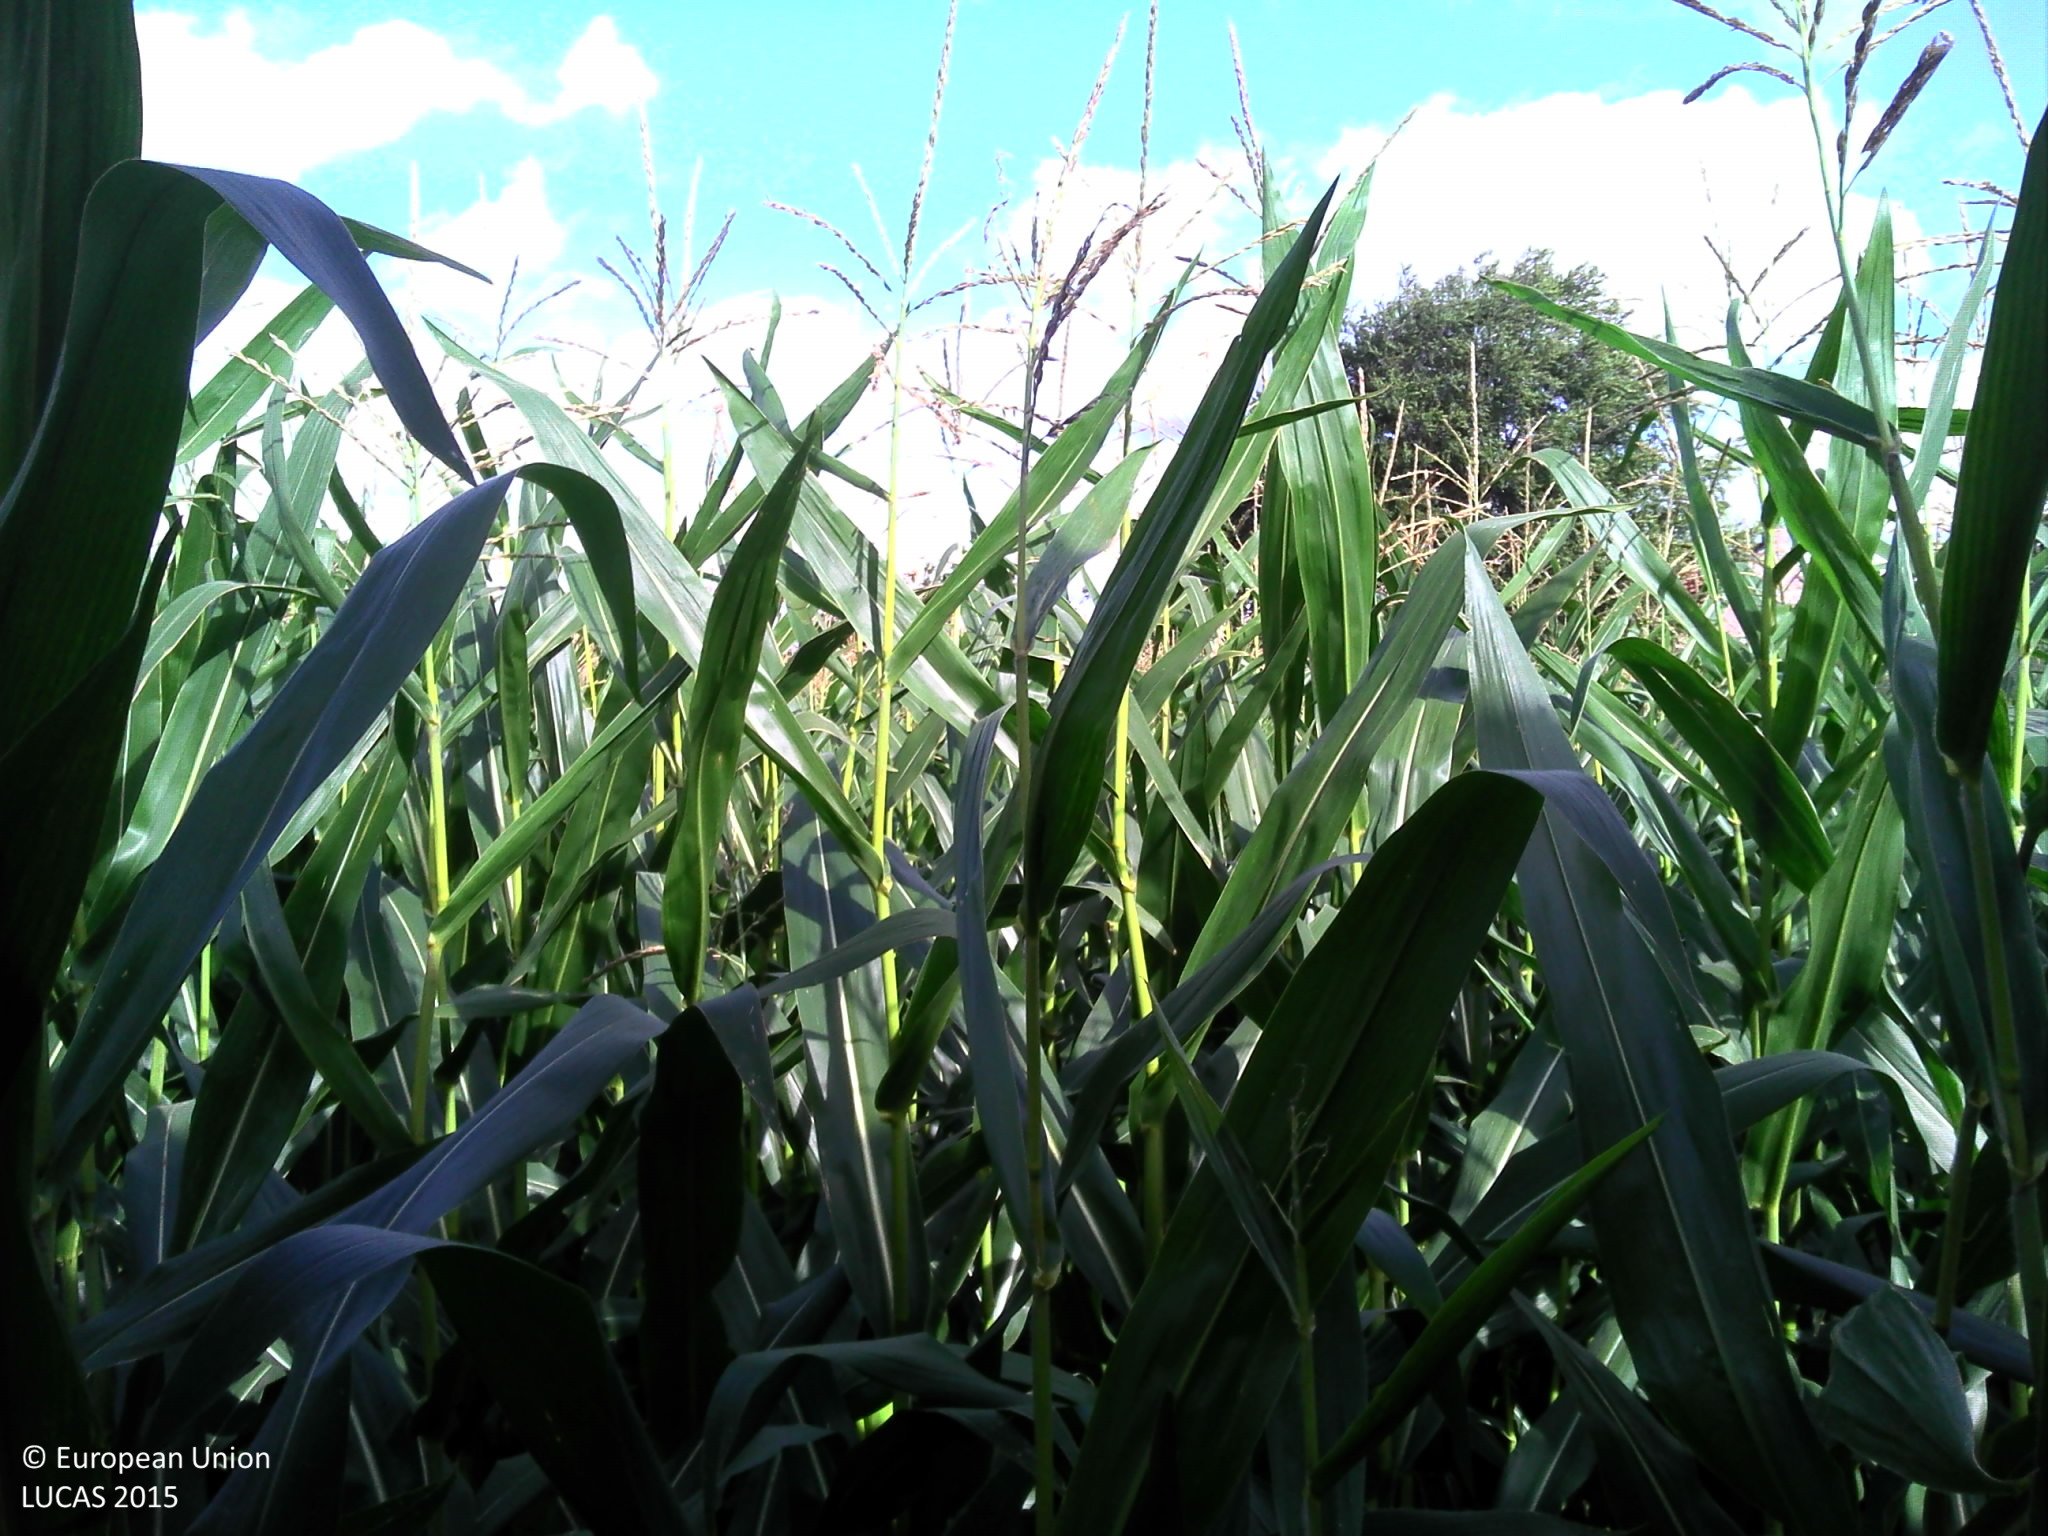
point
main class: Cropland
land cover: Maize
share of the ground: > 75 %
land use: Agriculture (excluding fallow land and kitchen gardens)
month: September
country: BE
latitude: 51.4206
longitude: 4.4880
